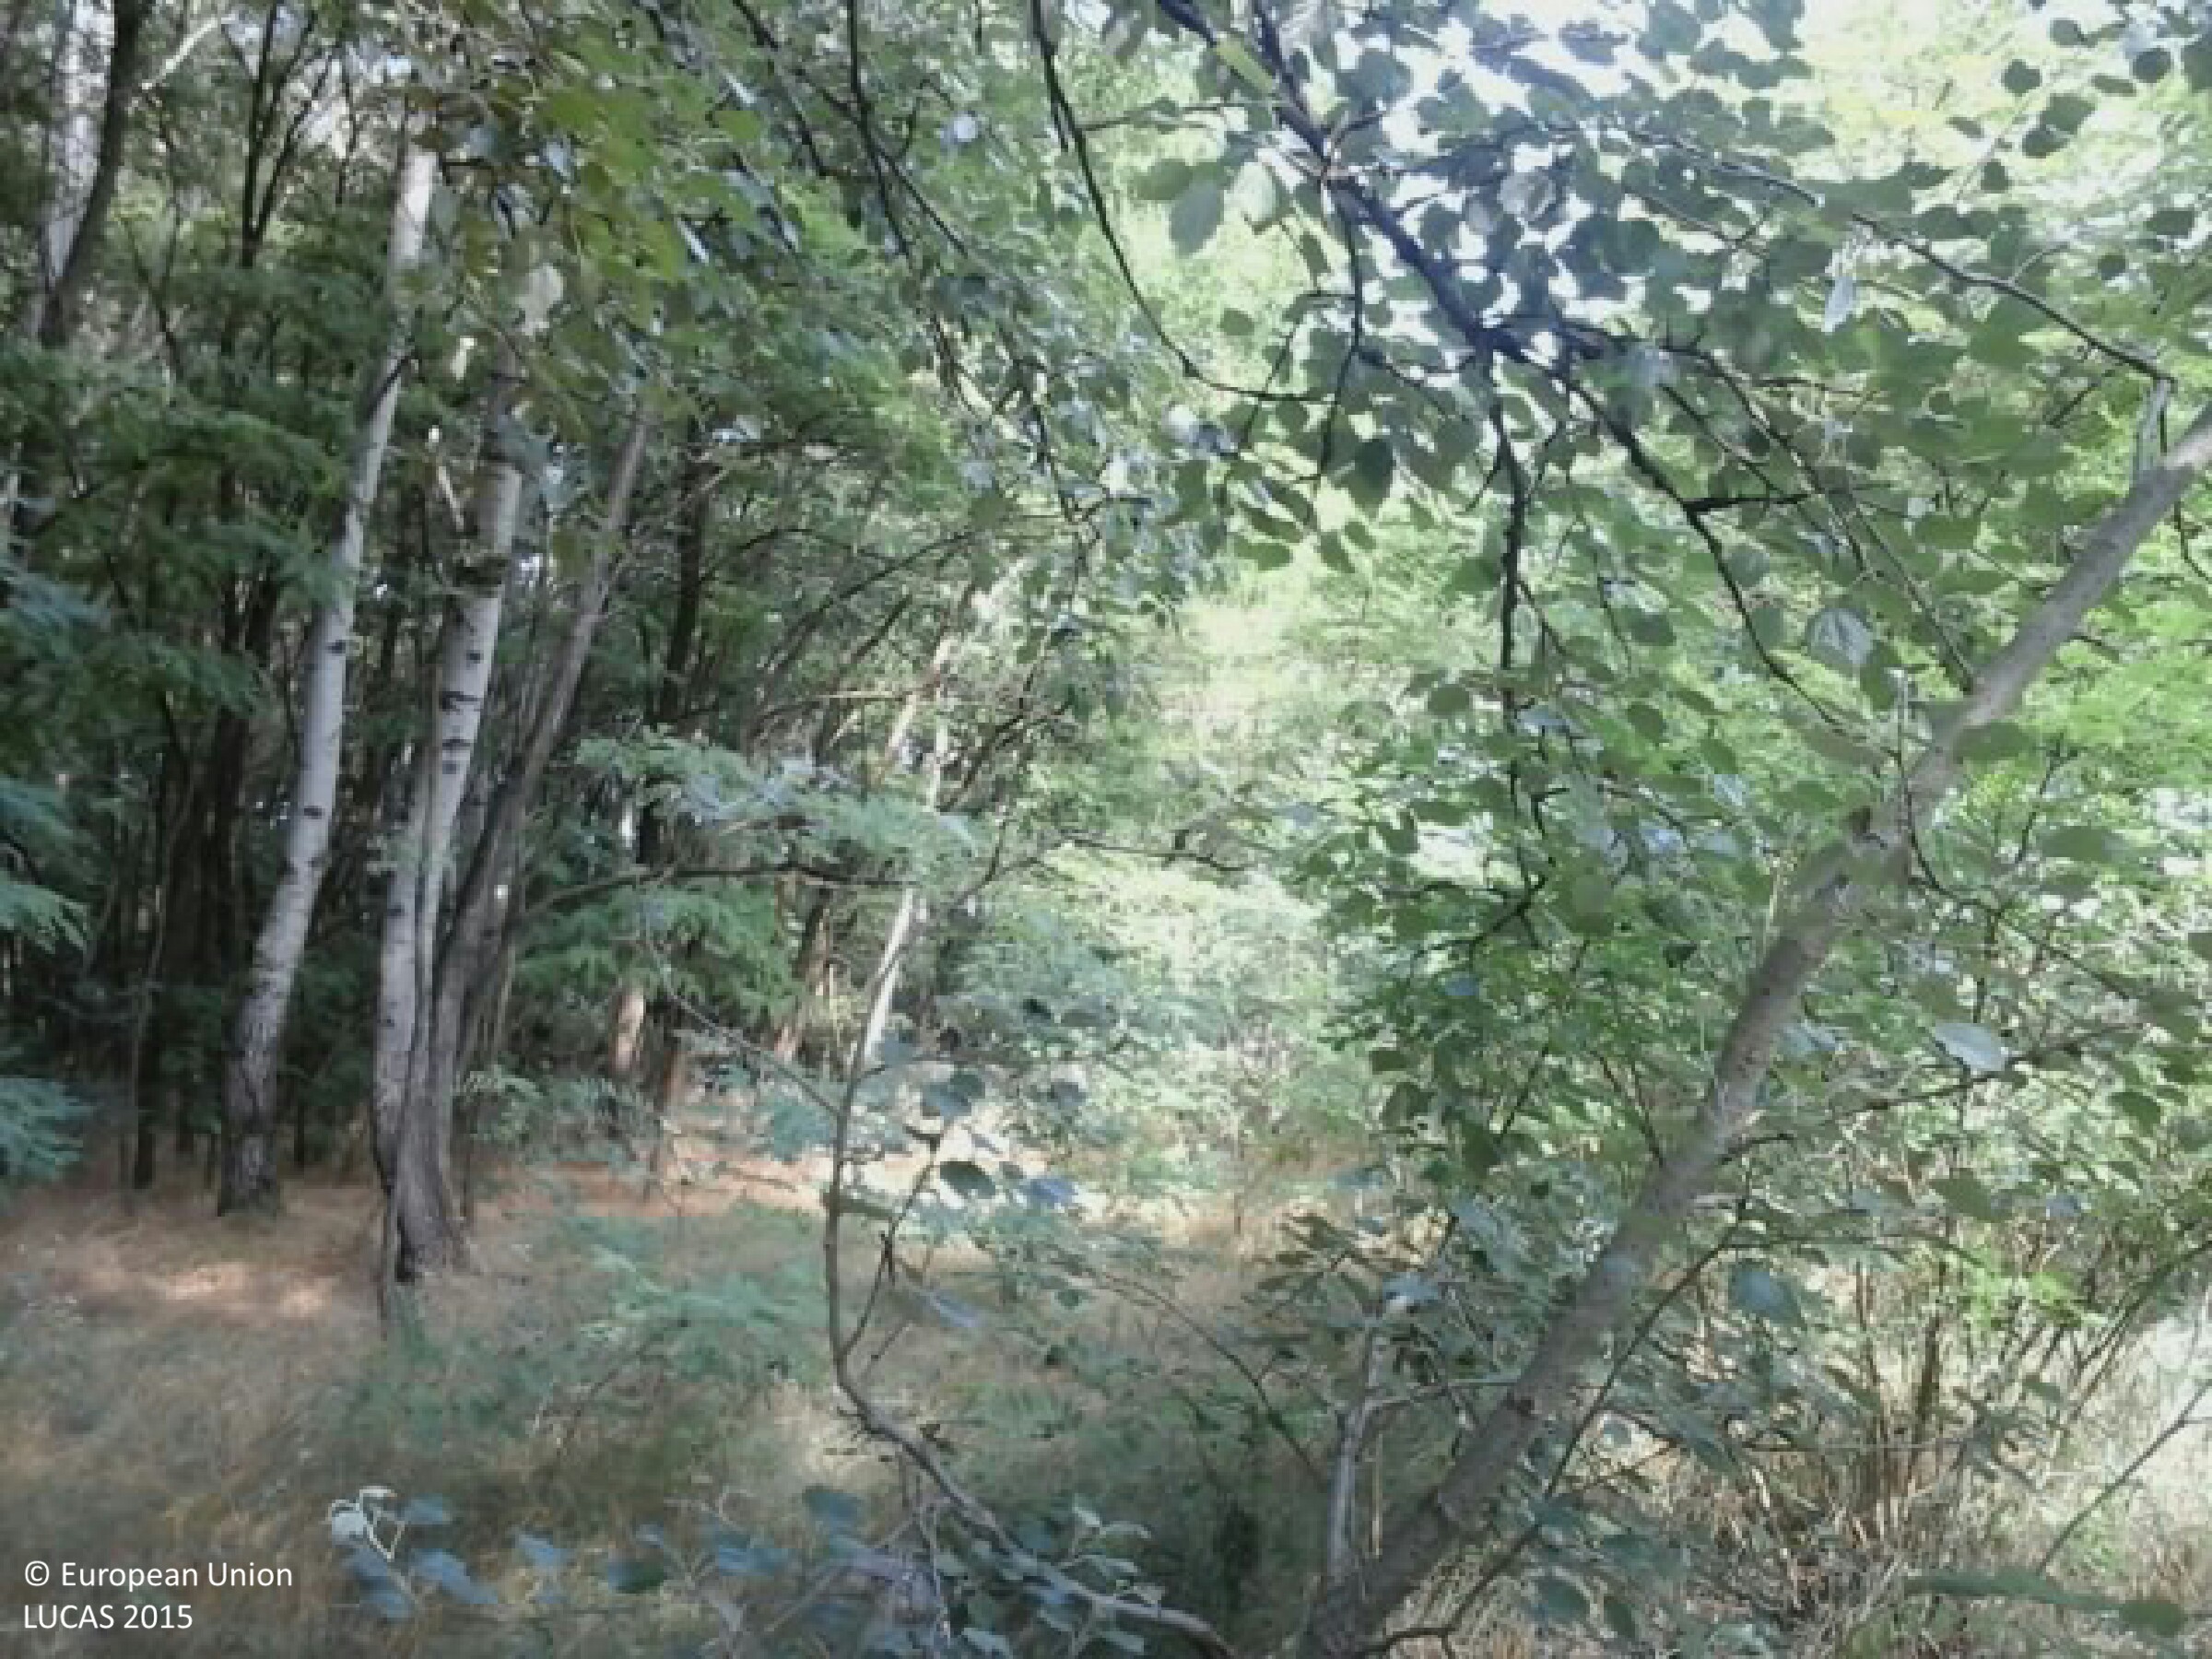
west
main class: Woodland
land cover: Broadleaved woodland
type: exotic forest
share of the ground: 50 - 75 %
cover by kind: broadleaved forest trees 90 %, herbaceous plants 10 %
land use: Forestry
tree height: > 5 m
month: June
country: HU
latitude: 46.8404
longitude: 19.6312
